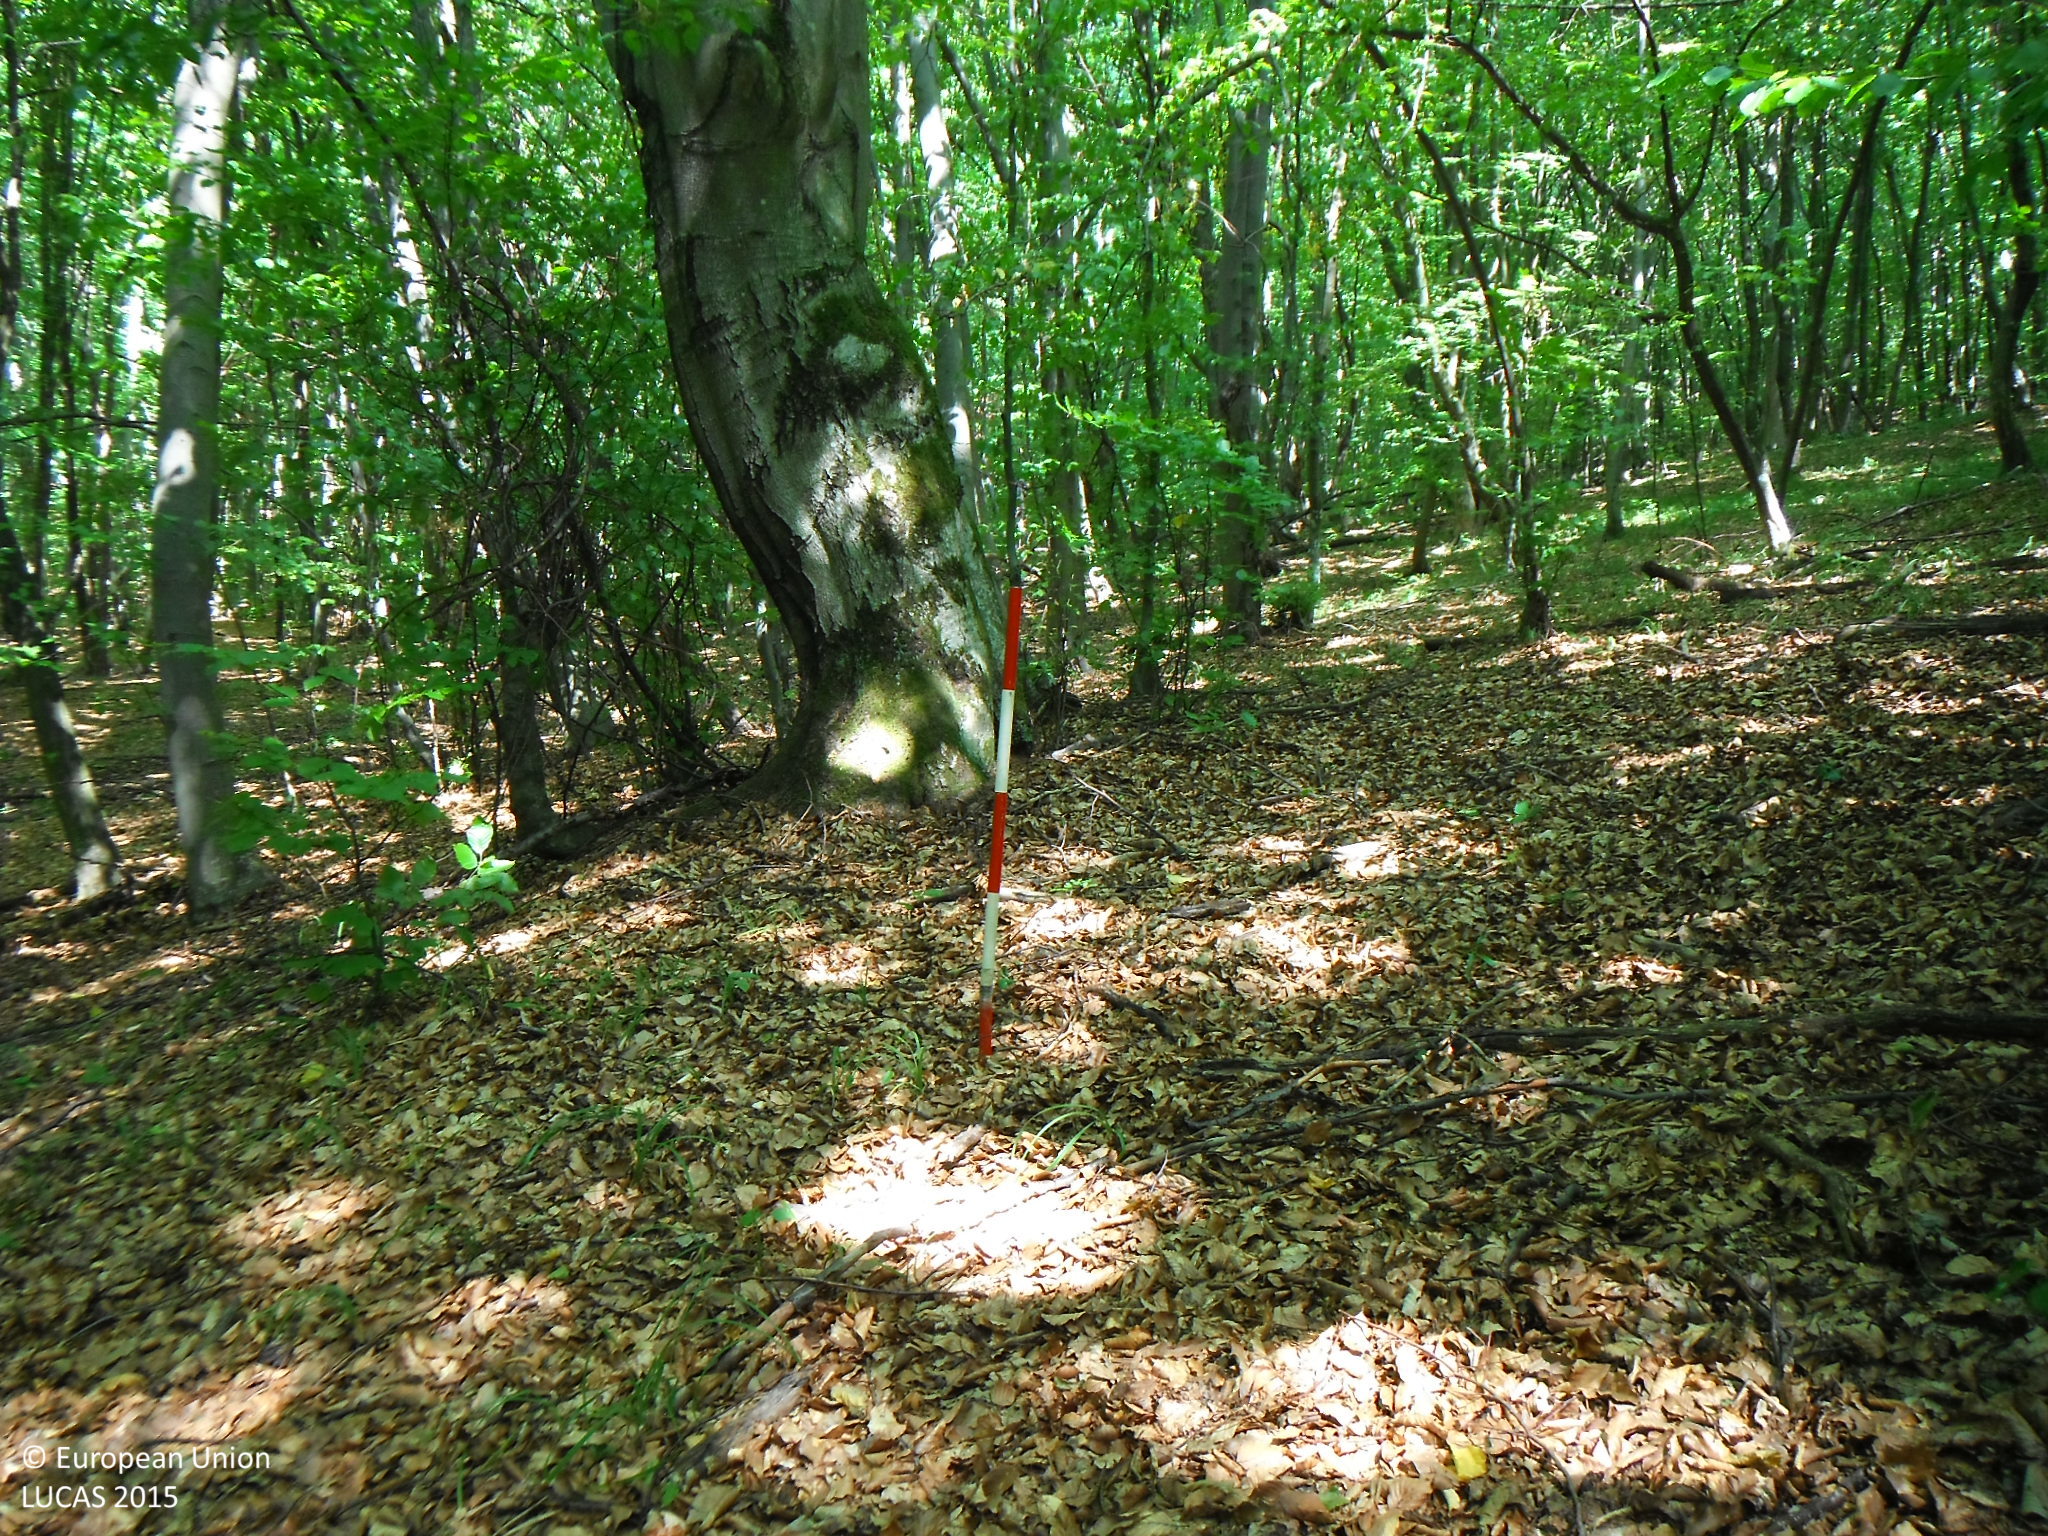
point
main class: Woodland
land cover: Broadleaved woodland
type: mesophytic deciduous forest
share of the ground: > 75 %
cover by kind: broadleaved forest trees 100 %
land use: Forestry
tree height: > 5 m
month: August
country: SK
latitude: 49.1509
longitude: 21.9698
